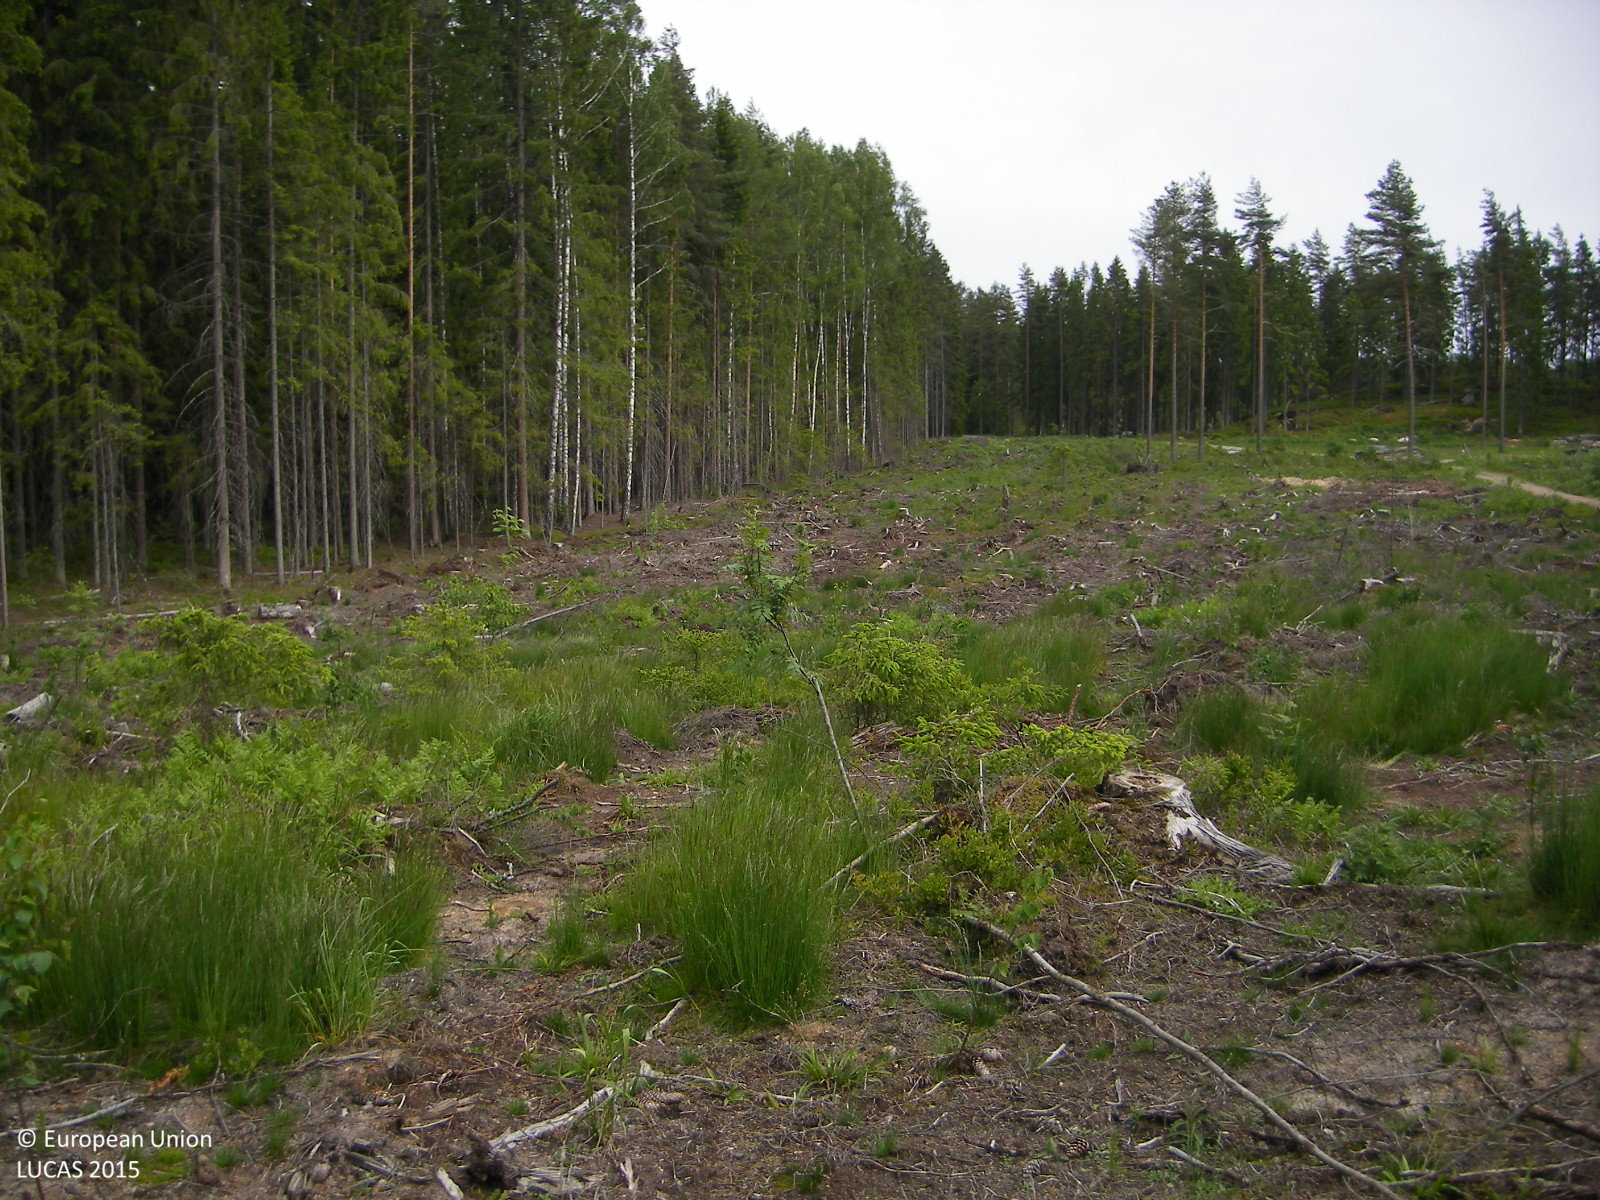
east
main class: Grassland
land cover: Grassland with sparse tree/shrub cover
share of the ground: 25 - 50 %
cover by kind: unconsolidated bare surface 50 %, herbaceous plants 40 %, broadleaved forest trees 5 %, shrubs 5 %
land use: Forestry
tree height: < 5 m
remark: Clear cut
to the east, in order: Grassland with sparse tree/shrub cover; Ditches and canals; Spruce dominated mixed woodland
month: June
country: FI
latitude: 60.3180
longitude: 24.3895
